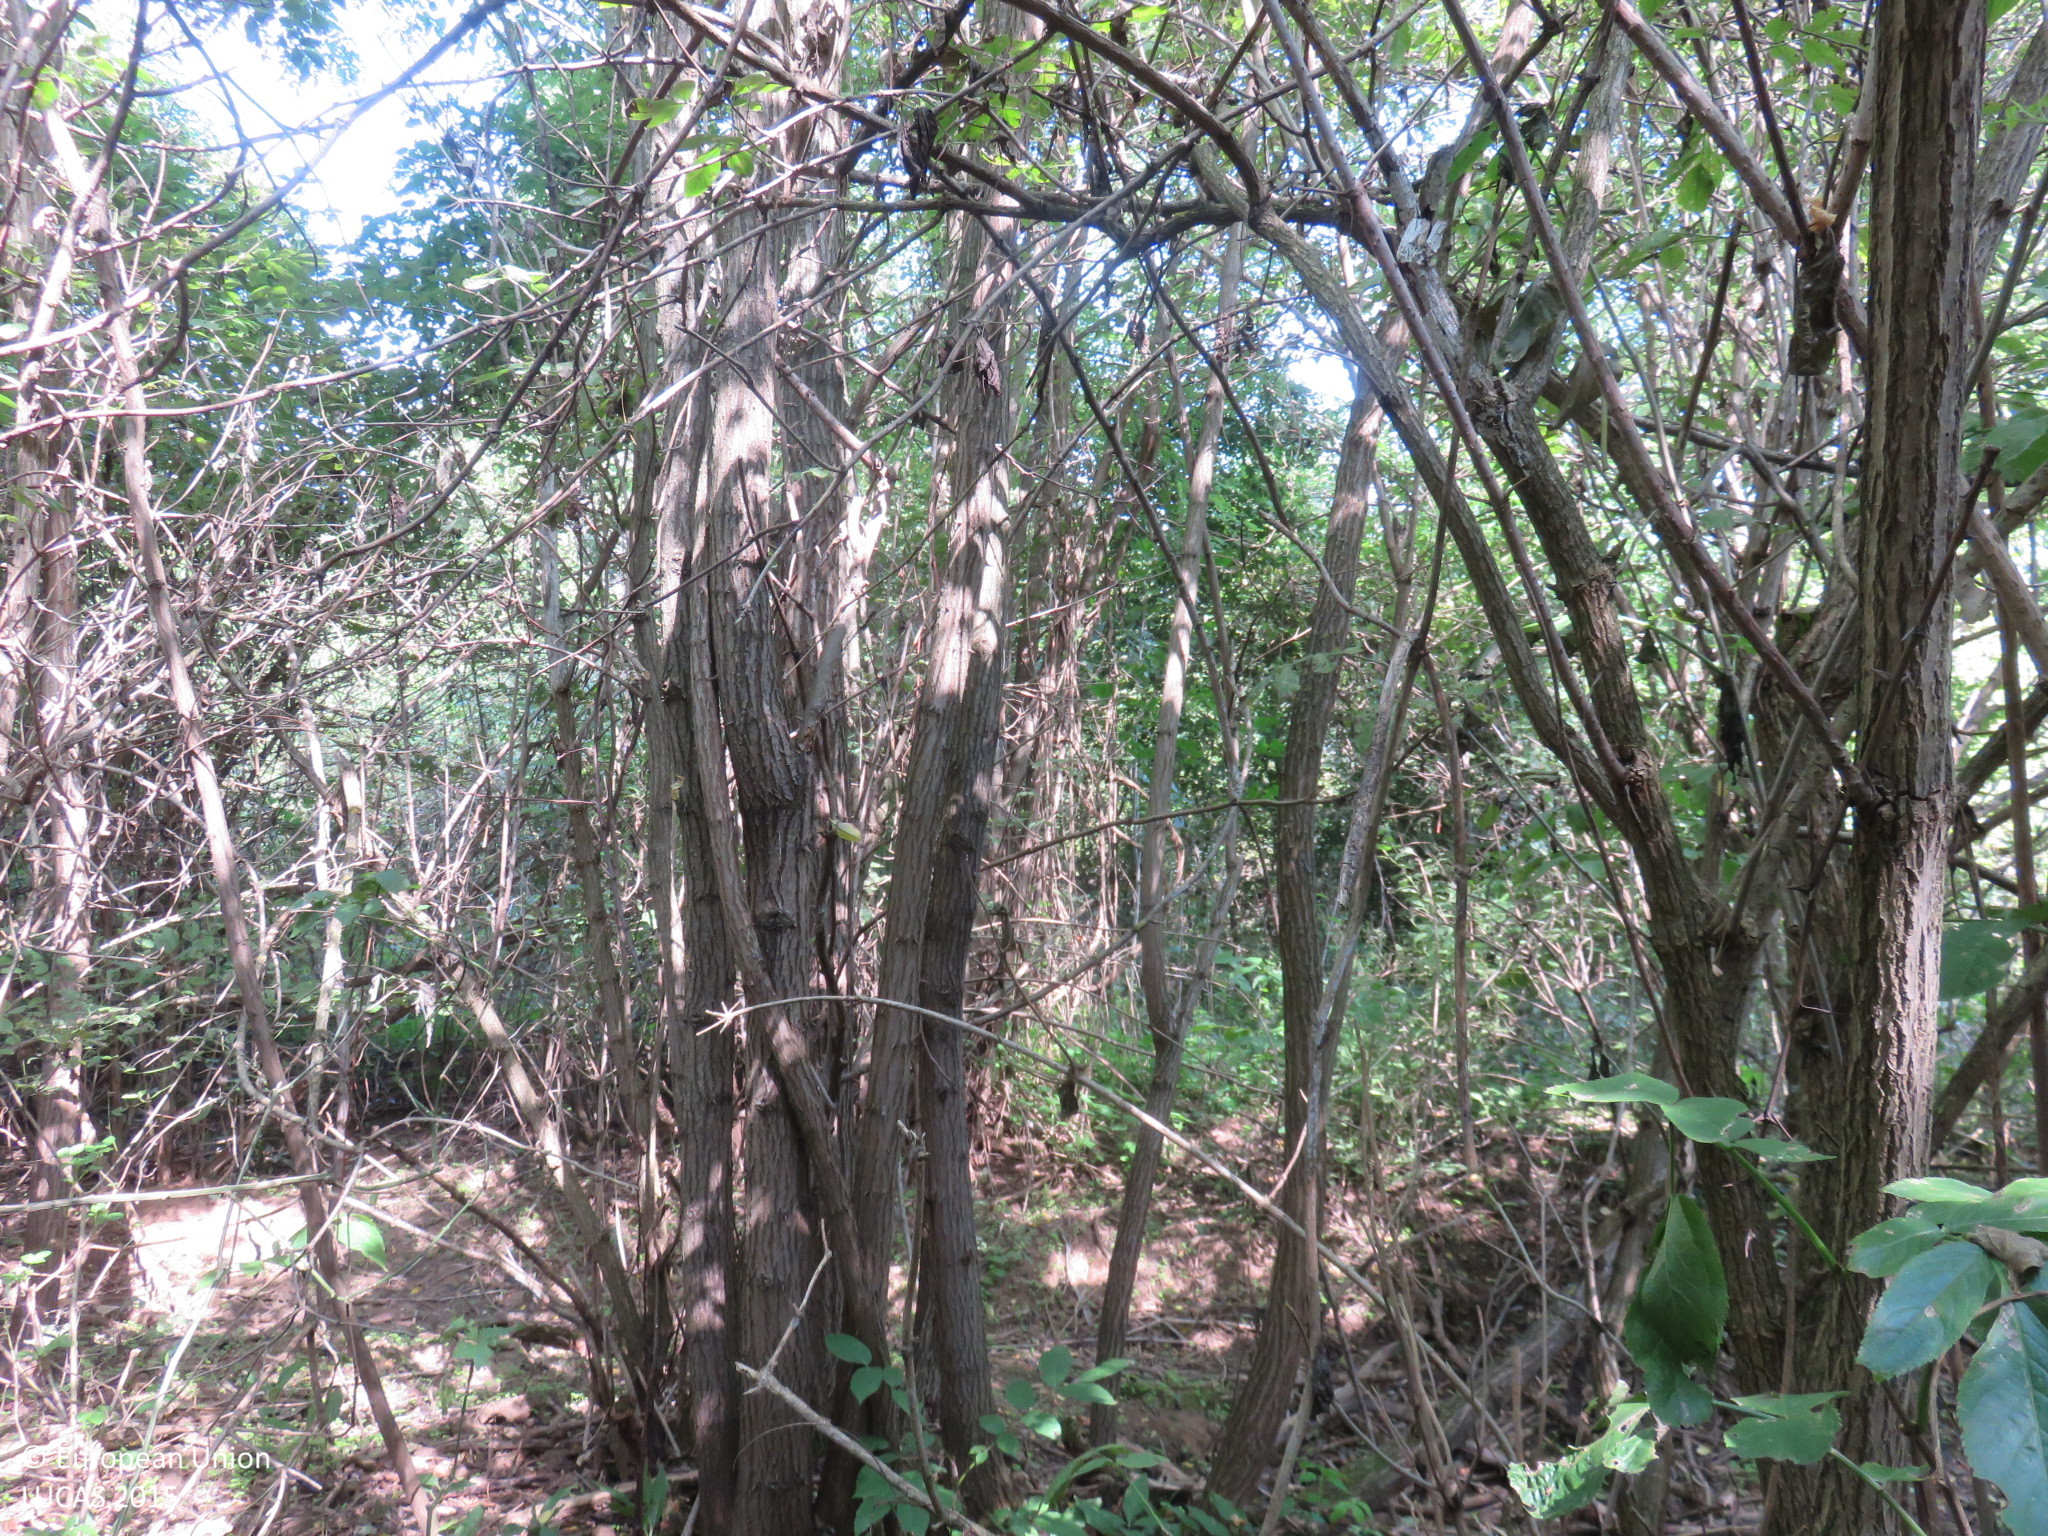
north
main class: Woodland
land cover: Broadleaved woodland
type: mesophytic deciduous forest
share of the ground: > 75 %
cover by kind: broadleaved forest trees 80 %, shrubs 20 %
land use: Semi-natural and natural areas not in use
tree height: < 5 m
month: September
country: BG
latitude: 43.6399
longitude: 24.9849
